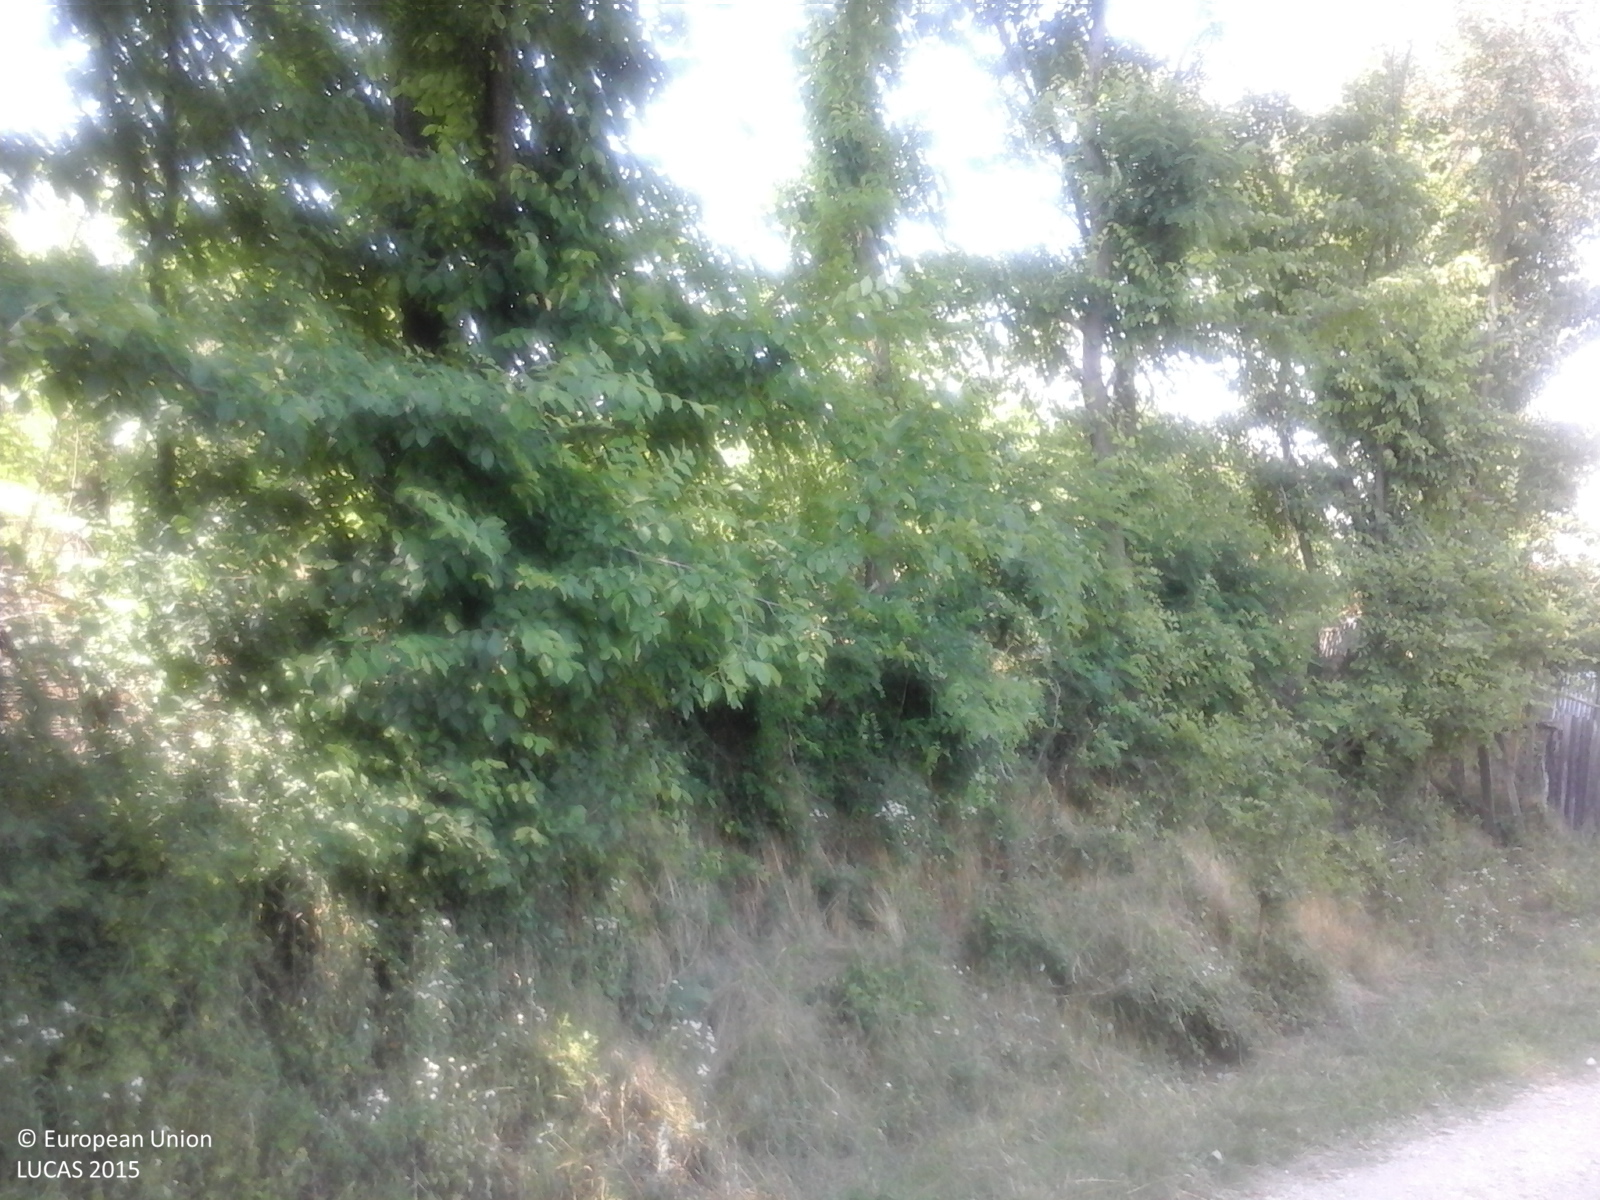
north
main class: Cropland
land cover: Pear fruit
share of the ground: > 75 %
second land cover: Grassland without tree/shrub cover
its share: > 75 %
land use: Agriculture (excluding fallow land and kitchen gardens)
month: July
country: RO
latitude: 45.0267
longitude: 24.7653
